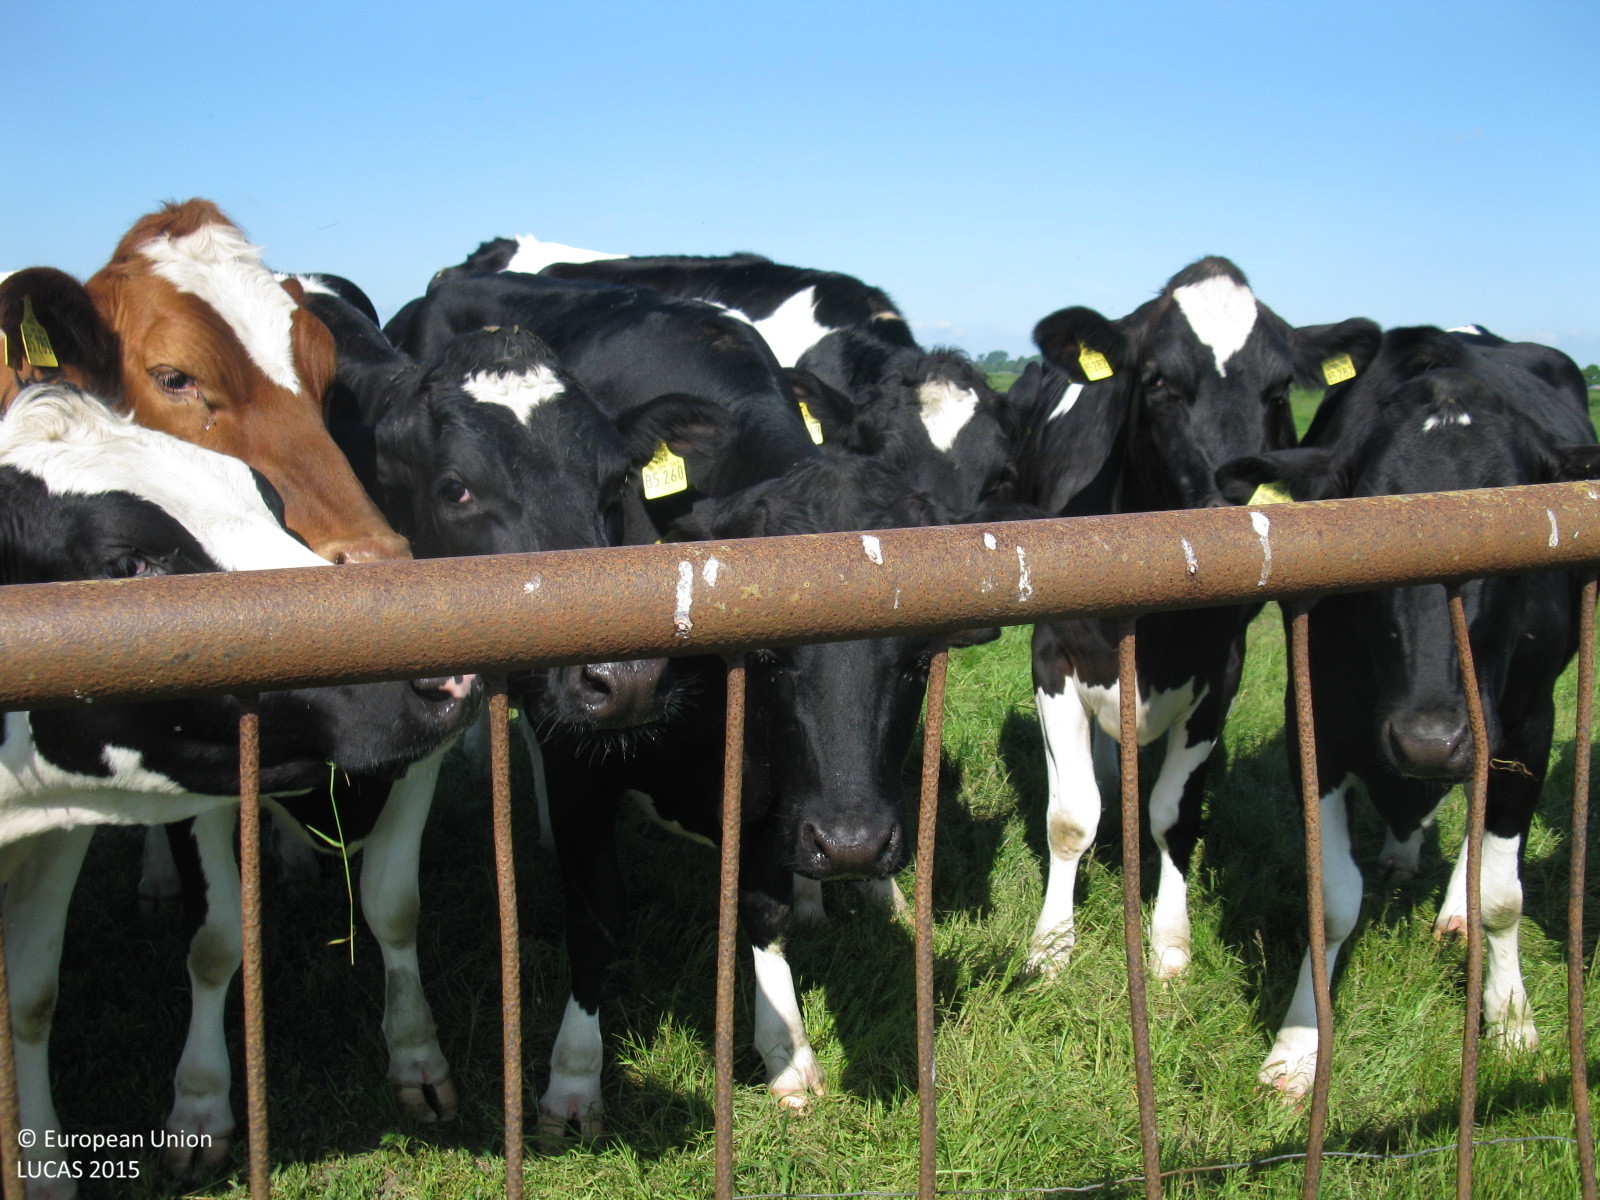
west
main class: Grassland
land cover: Grassland without tree/shrub cover
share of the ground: > 75 %
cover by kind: herbaceous plants 100 %
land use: Agriculture (excluding fallow land and kitchen gardens)
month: June
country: DE
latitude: 53.2471
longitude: 7.3480
